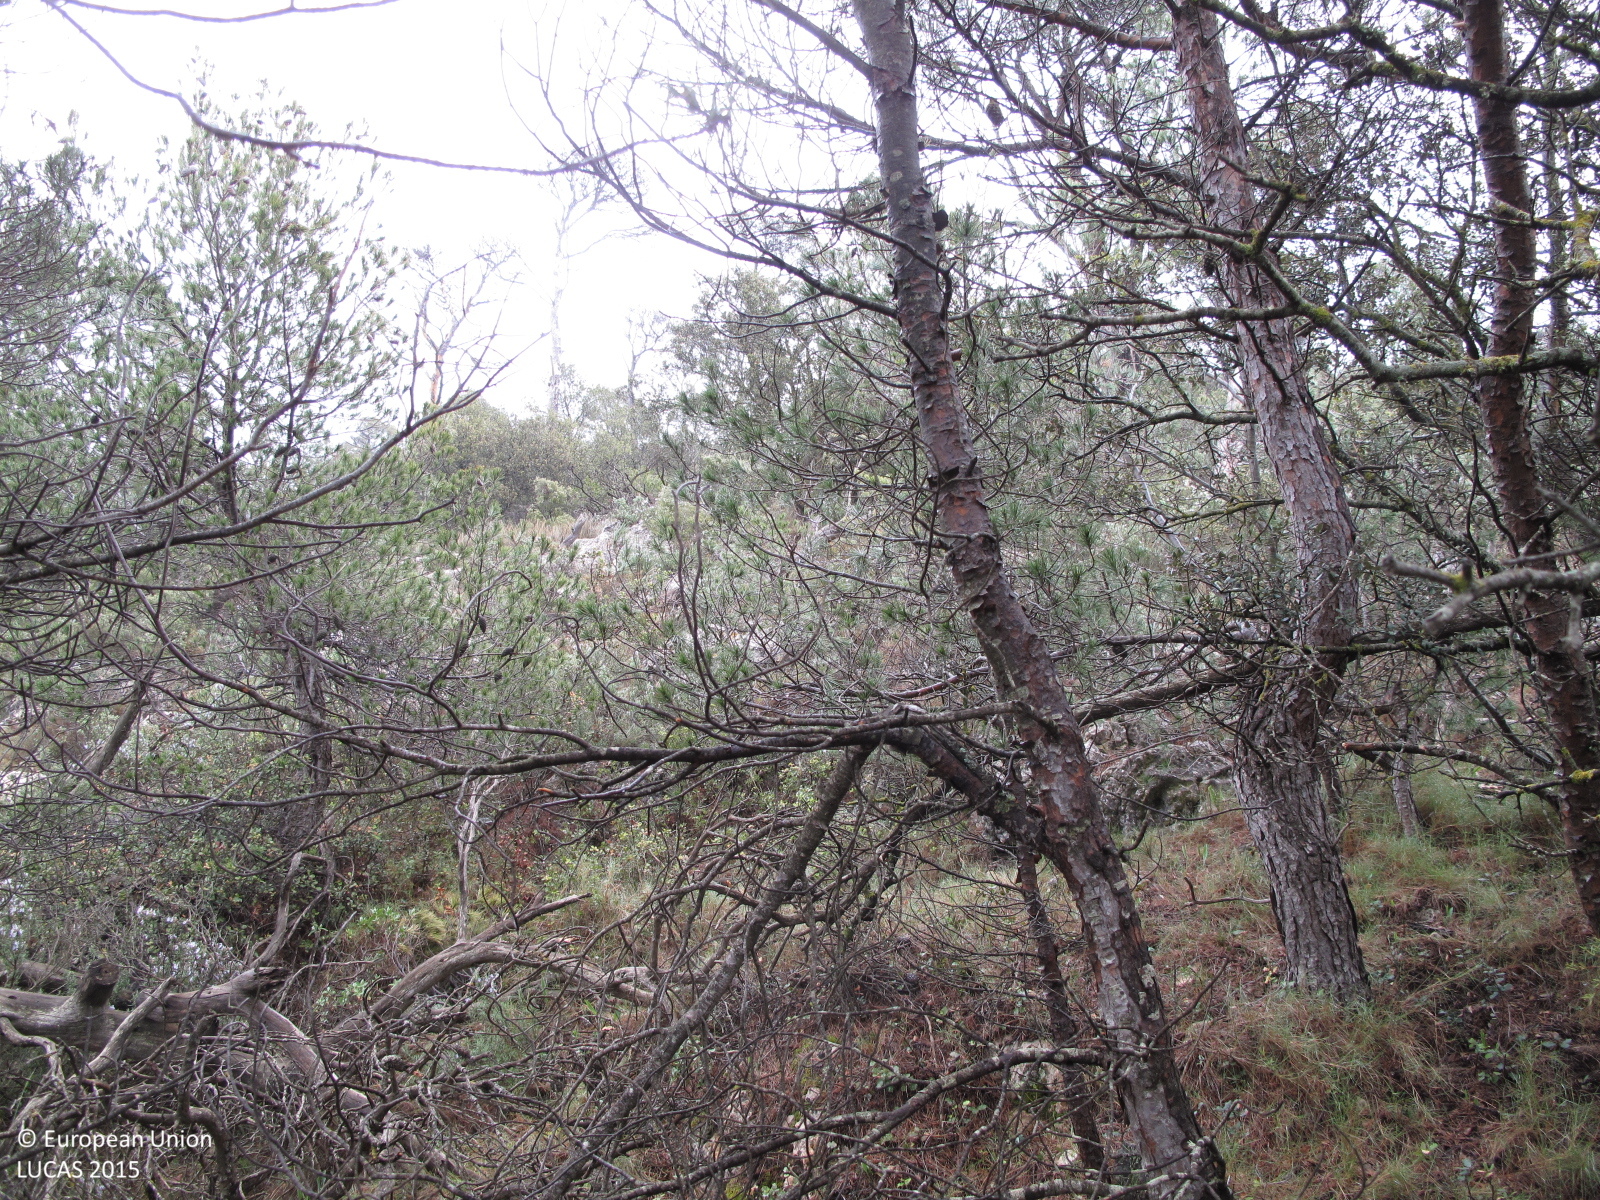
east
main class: Woodland
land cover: Pine dominated coniferous woodland
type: coniferous forest of the mediterranean region
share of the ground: 50 - 75 %
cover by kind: coniferous forest trees 65 %, shrubs 15 %, herbaceous plants 15 %, unconsolidated bare surface 5 %
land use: Semi-natural and natural areas not in use
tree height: > 5 m
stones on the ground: < 10 %
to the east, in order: Pine dominated coniferous woodland
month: April
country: ES
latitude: 38.4931
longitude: -1.0305
